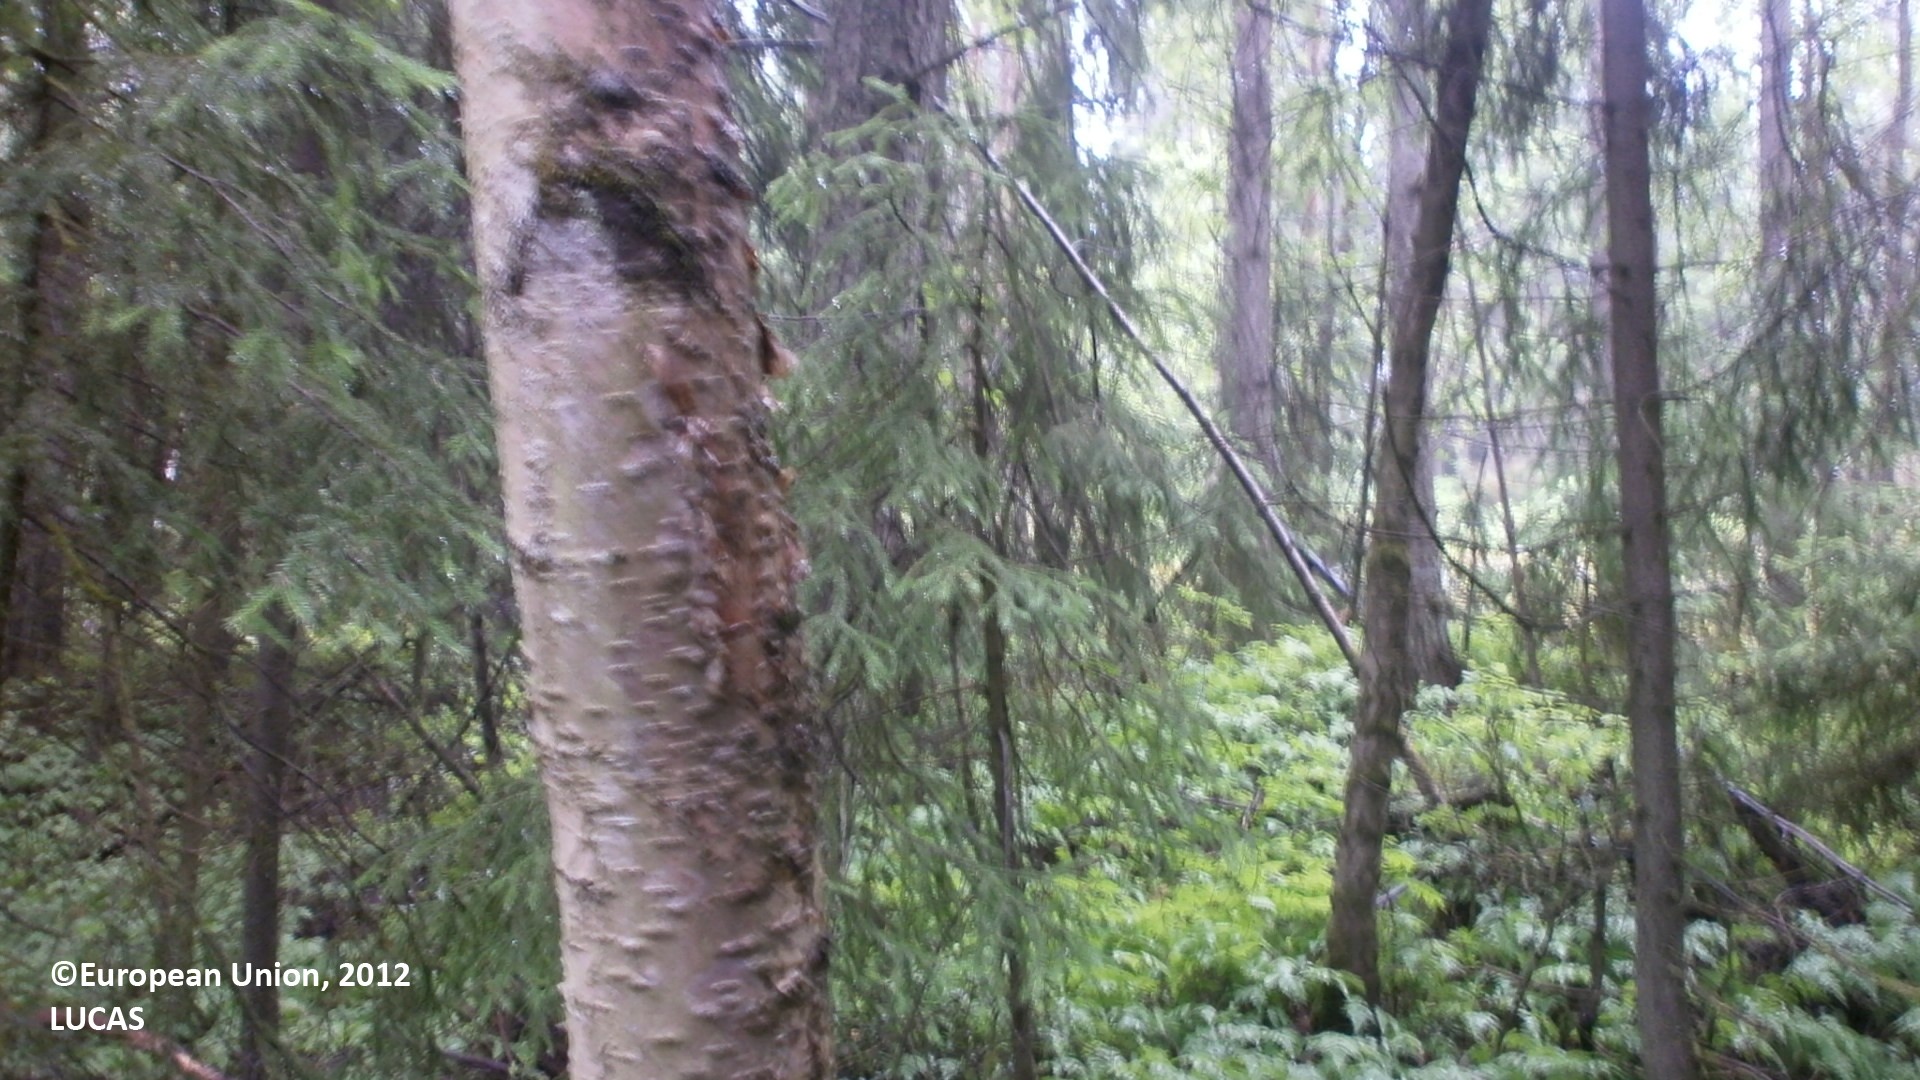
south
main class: Woodland
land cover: Spruce dominated mixed woodland
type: boreal forest
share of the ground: > 75 %
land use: Forestry
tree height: > 5 m
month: July
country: FI
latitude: 64.6537
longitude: 24.4495
